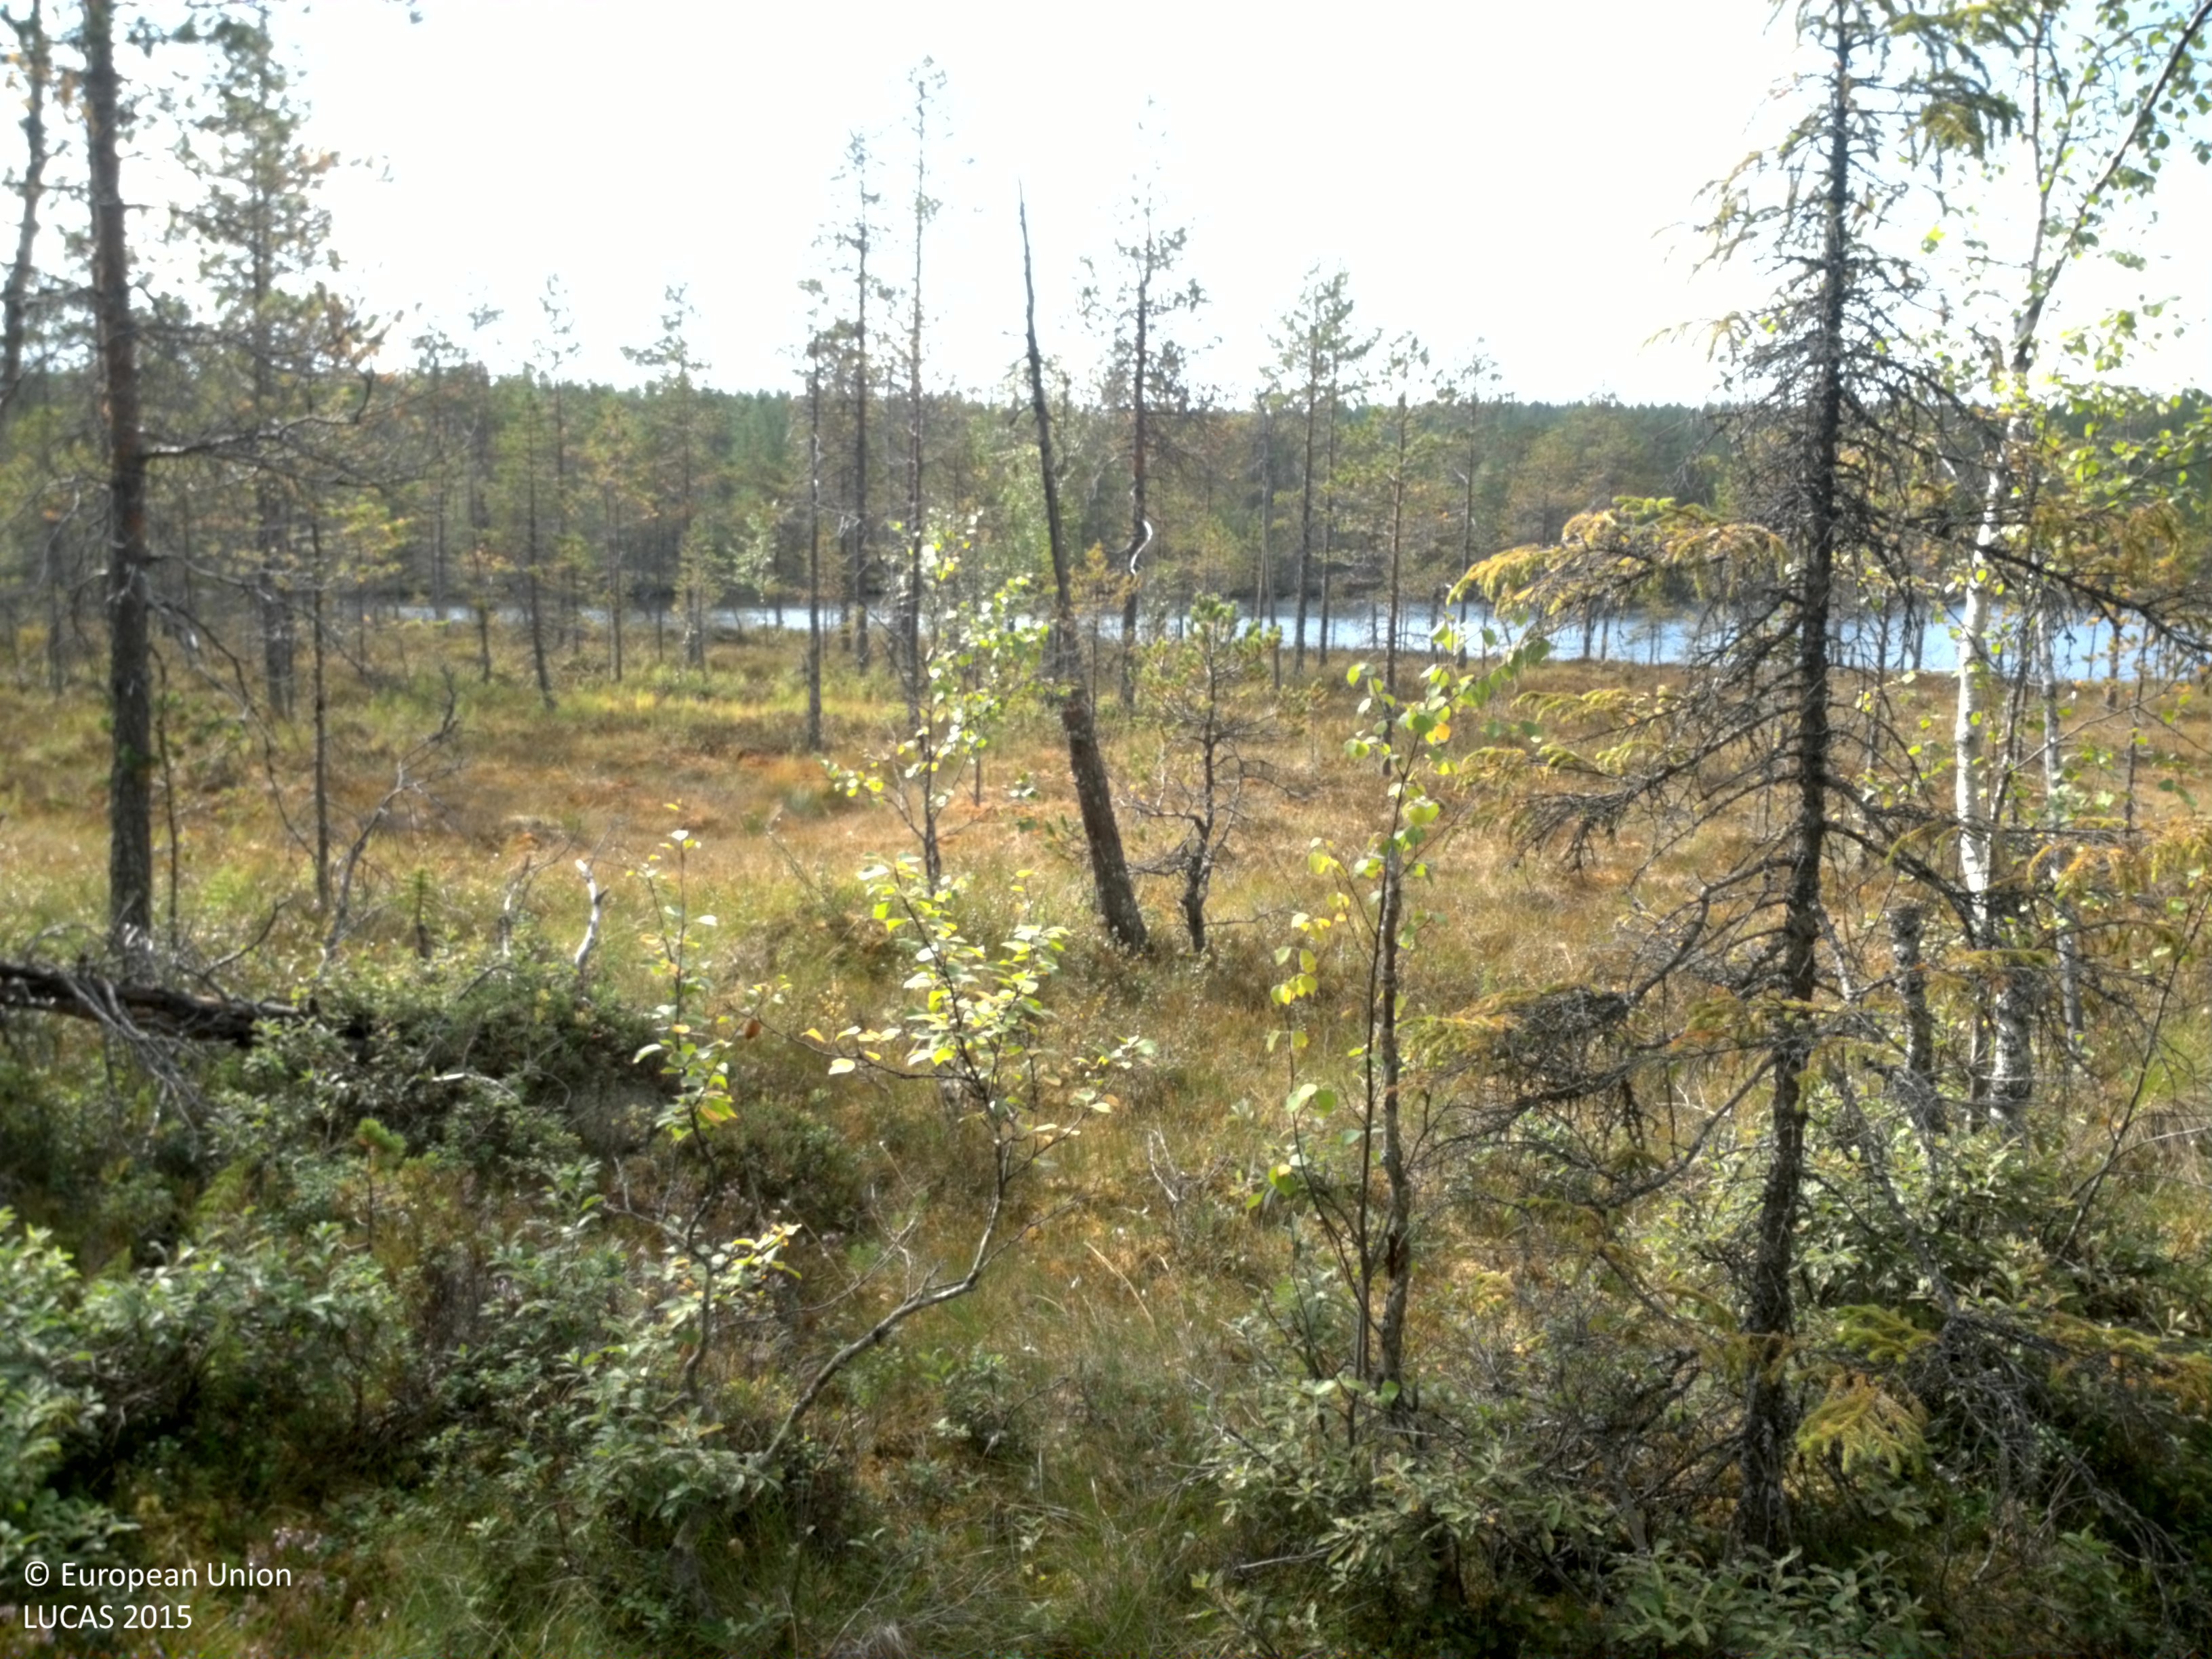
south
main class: Woodland
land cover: Pine dominated mixed woodland
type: boreal forest
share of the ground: 25 - 50 %
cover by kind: coniferous forest trees 35 %, lichens and mosses 25 %, shrubs 20 %, broadleaved forest trees 15 %, herbaceous plants 5 %
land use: Forestry
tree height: > 5 m
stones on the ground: < 10 %
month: August
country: SE
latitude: 61.8628
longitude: 14.9443
